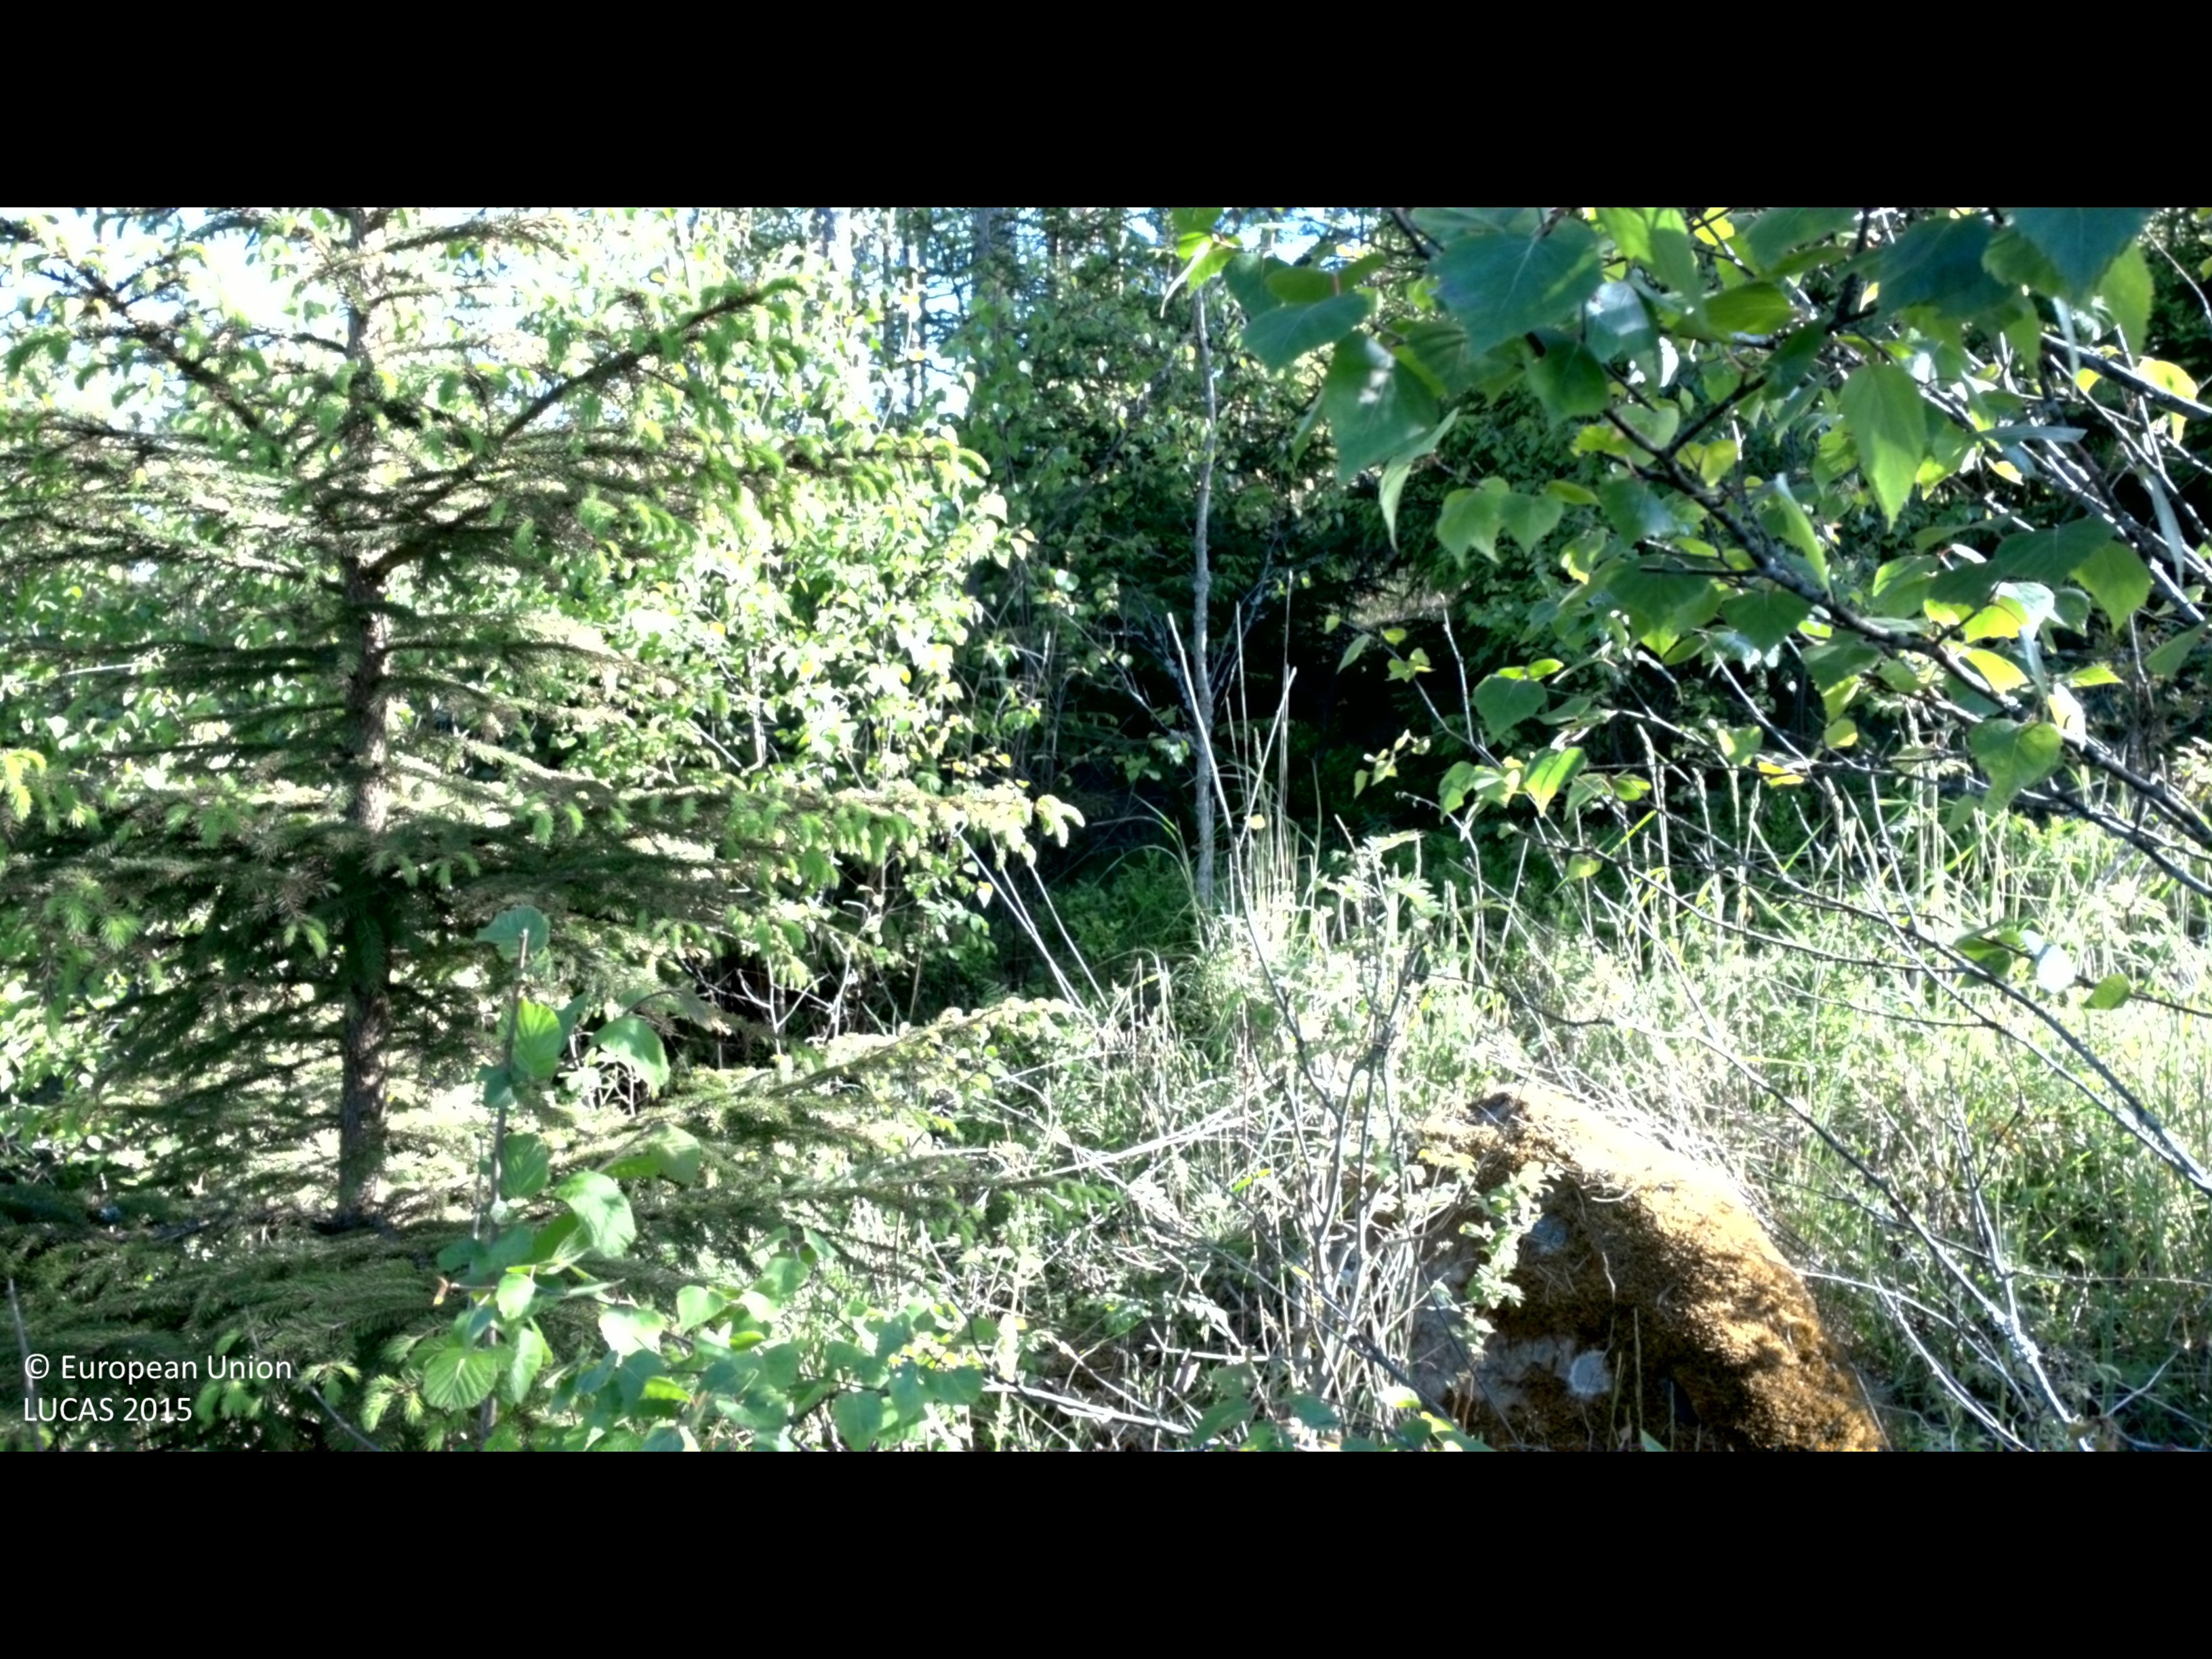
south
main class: Woodland
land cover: Spruce dominated mixed woodland
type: hemiboreal forest and nemoral coniferous forest and mixed broadleaved-coniferous forest
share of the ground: 25 - 50 %
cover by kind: herbaceous plants 40 %, shrubs 25 %, coniferous forest trees 20 %, broadleaved forest trees 15 %
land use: Forestry
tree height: > 5 m
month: June
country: SE
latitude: 57.8413
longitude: 16.2131
